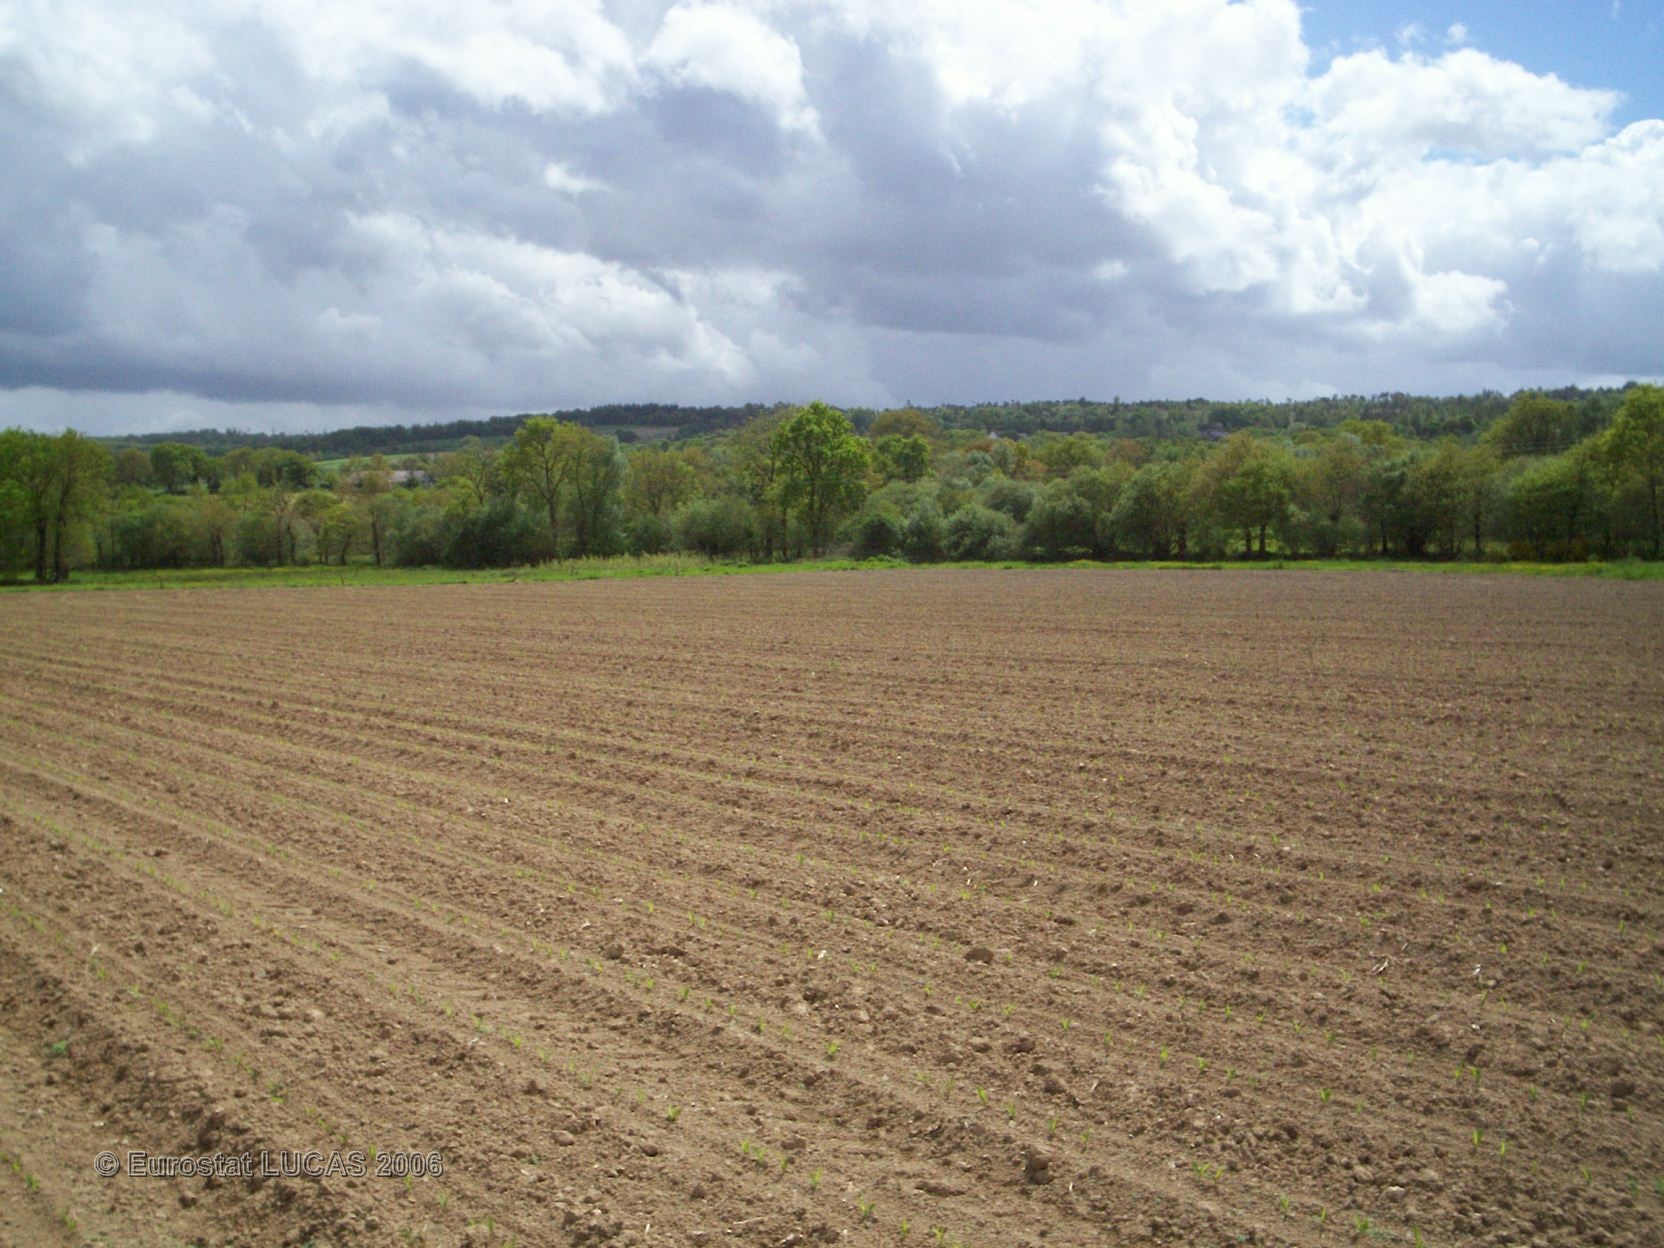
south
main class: Cropland
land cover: Maize
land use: Agriculture (excluding fallow land and kitchen gardens)
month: May
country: FR
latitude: 48.3783
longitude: -2.8528
